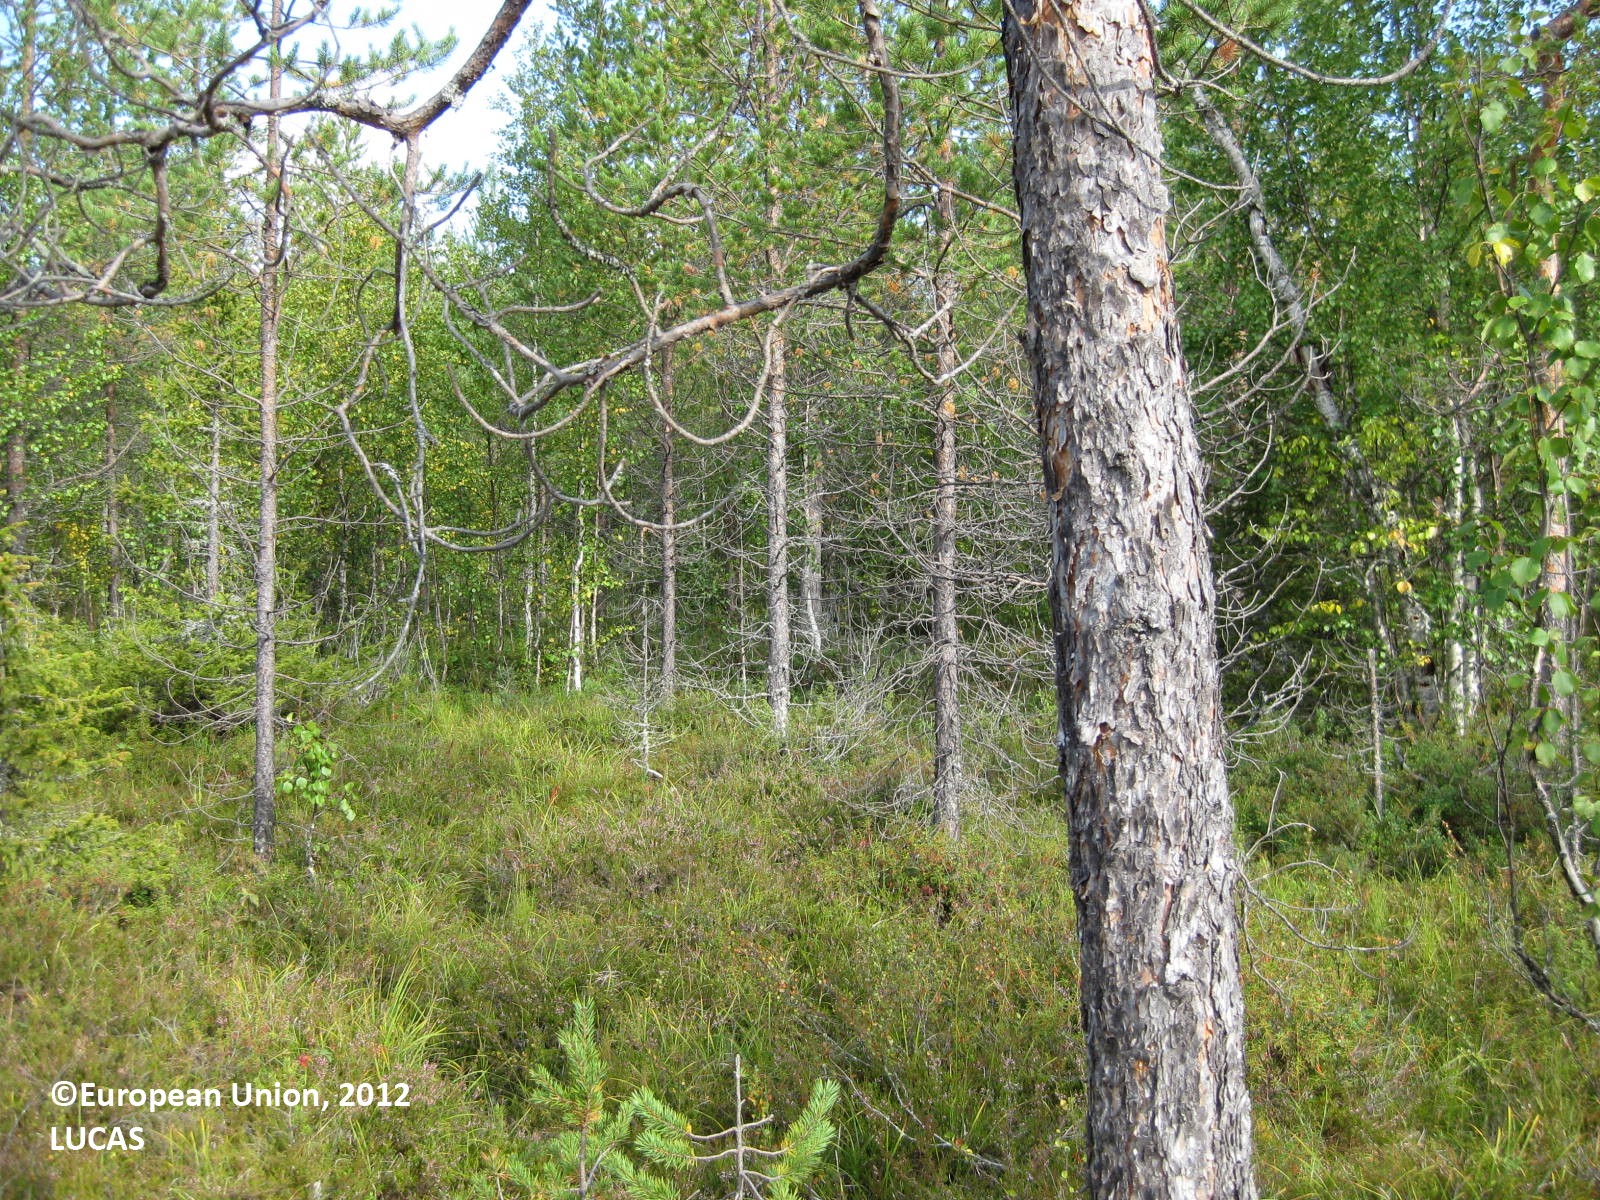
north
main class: Woodland
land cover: Pine dominated coniferous woodland
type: boreal forest
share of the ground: 25 - 50 %
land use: Forestry
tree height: > 5 m
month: August
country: FI
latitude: 66.2192
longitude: 29.7308
